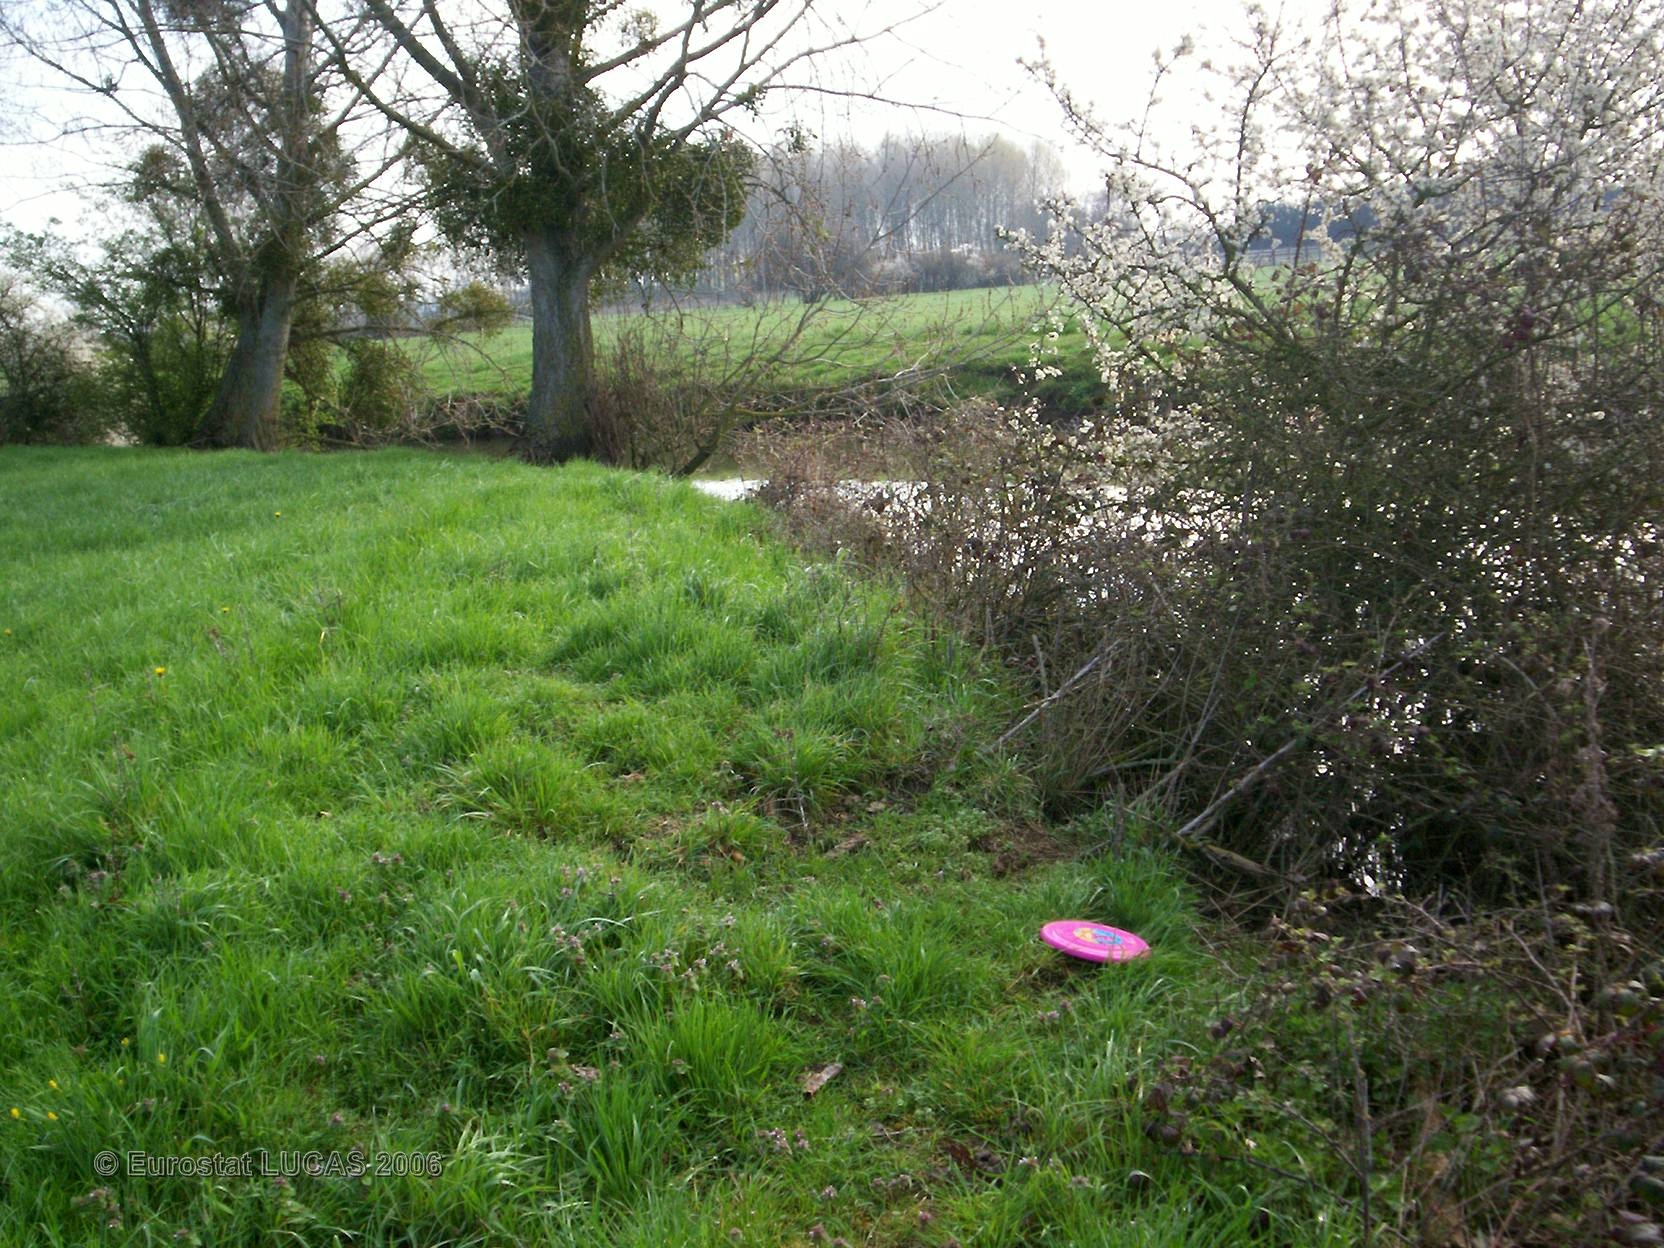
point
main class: Grassland
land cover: Grassland with sparse tree/shrub cover
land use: Agriculture (excluding fallow land and kitchen gardens)
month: April
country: FR
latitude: 48.1889
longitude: 0.2482
